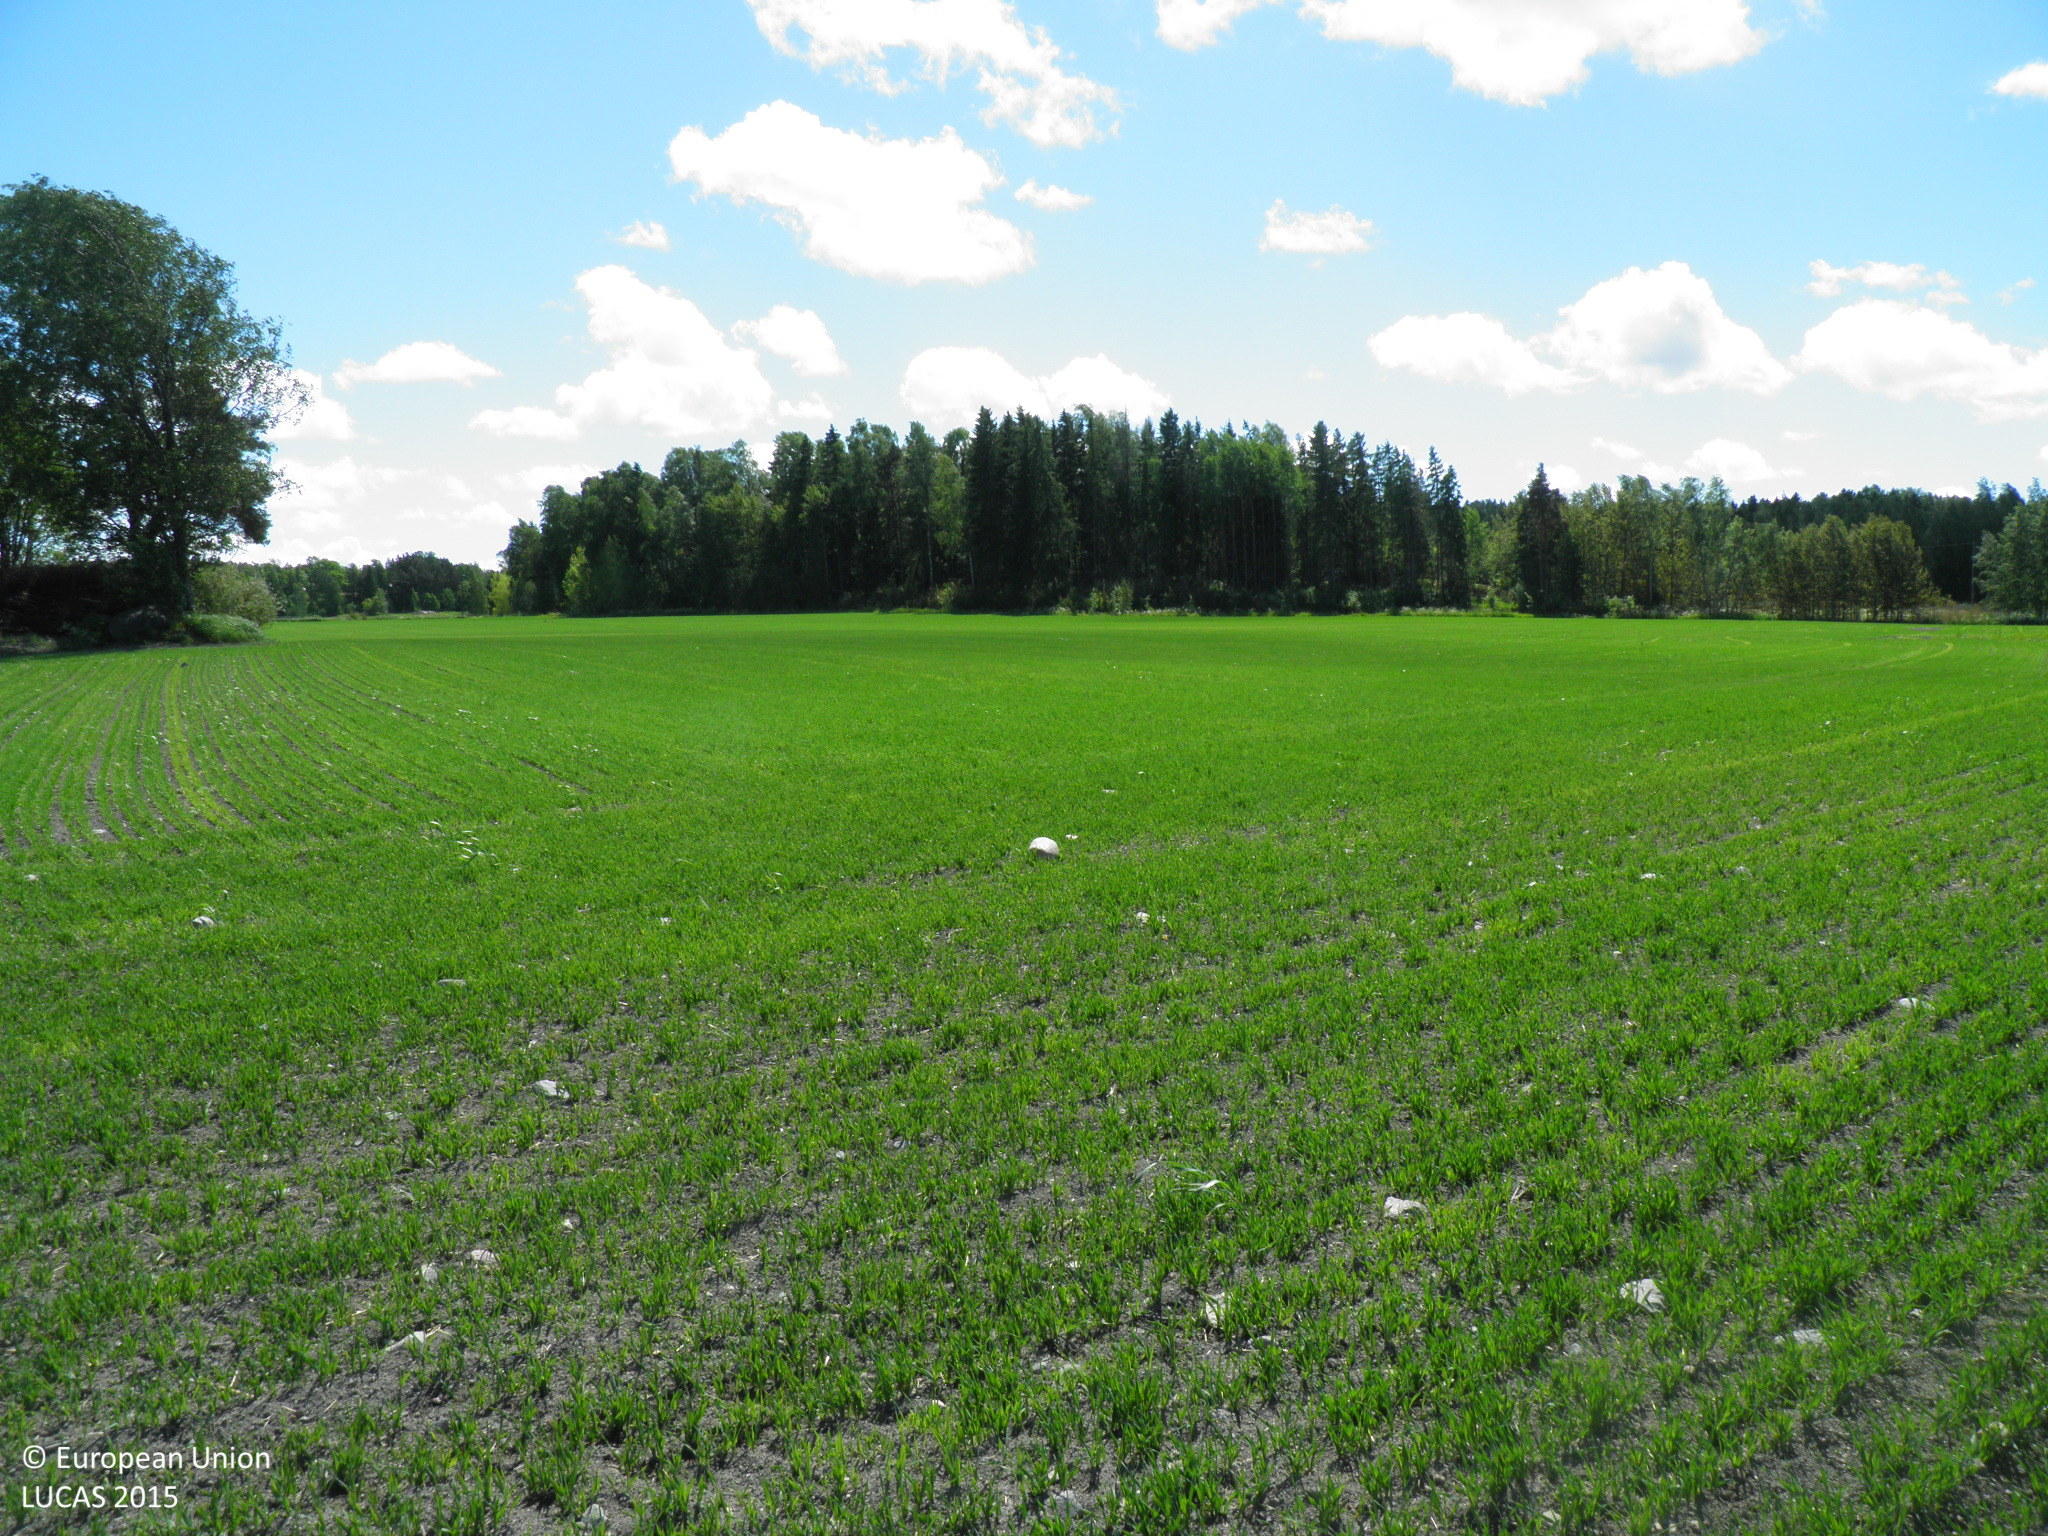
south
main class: Cropland
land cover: Barley
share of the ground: 50 - 75 %
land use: Agriculture (excluding fallow land and kitchen gardens)
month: June
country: FI
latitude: 60.5032
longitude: 22.0256
